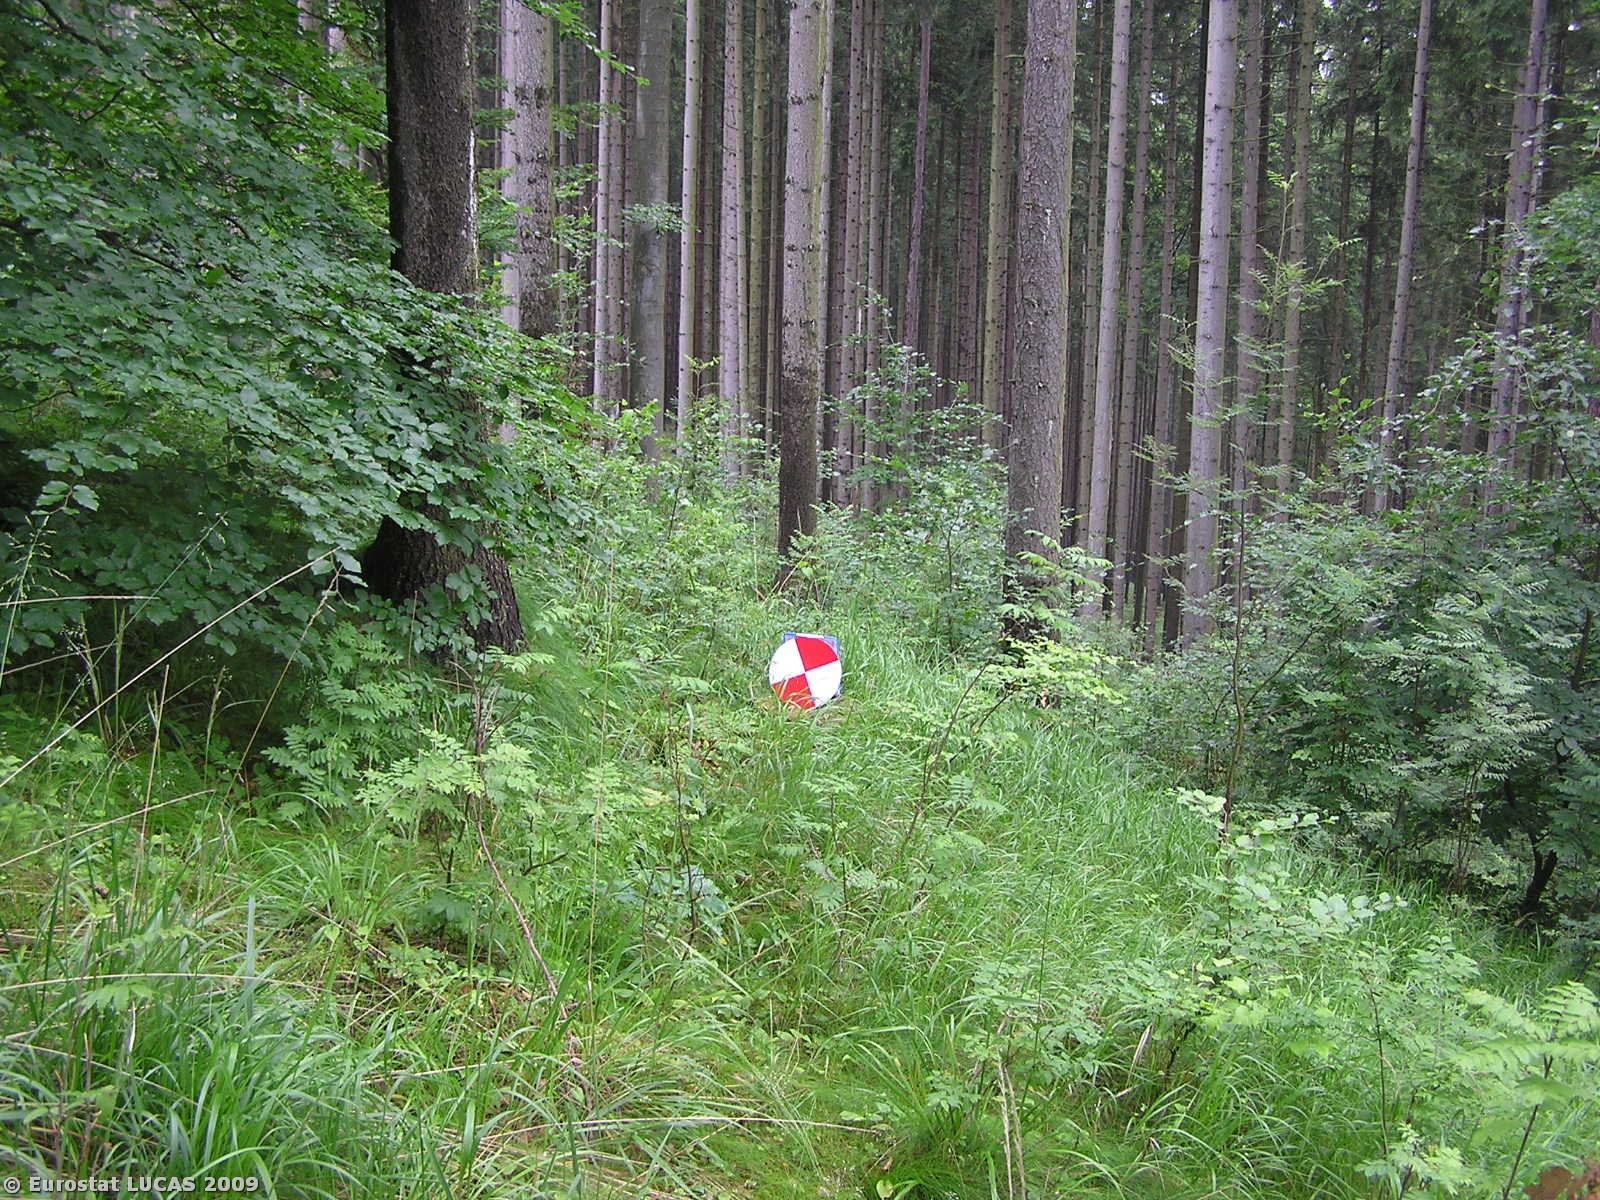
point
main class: Woodland
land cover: Mixed woodland
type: hemiboreal forest and nemoral coniferous forest and mixed broadleaved-coniferous forest
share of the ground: > 75 %
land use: Forestry
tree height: > 5 m
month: June
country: CZ
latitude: 50.1038
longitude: 17.4362
